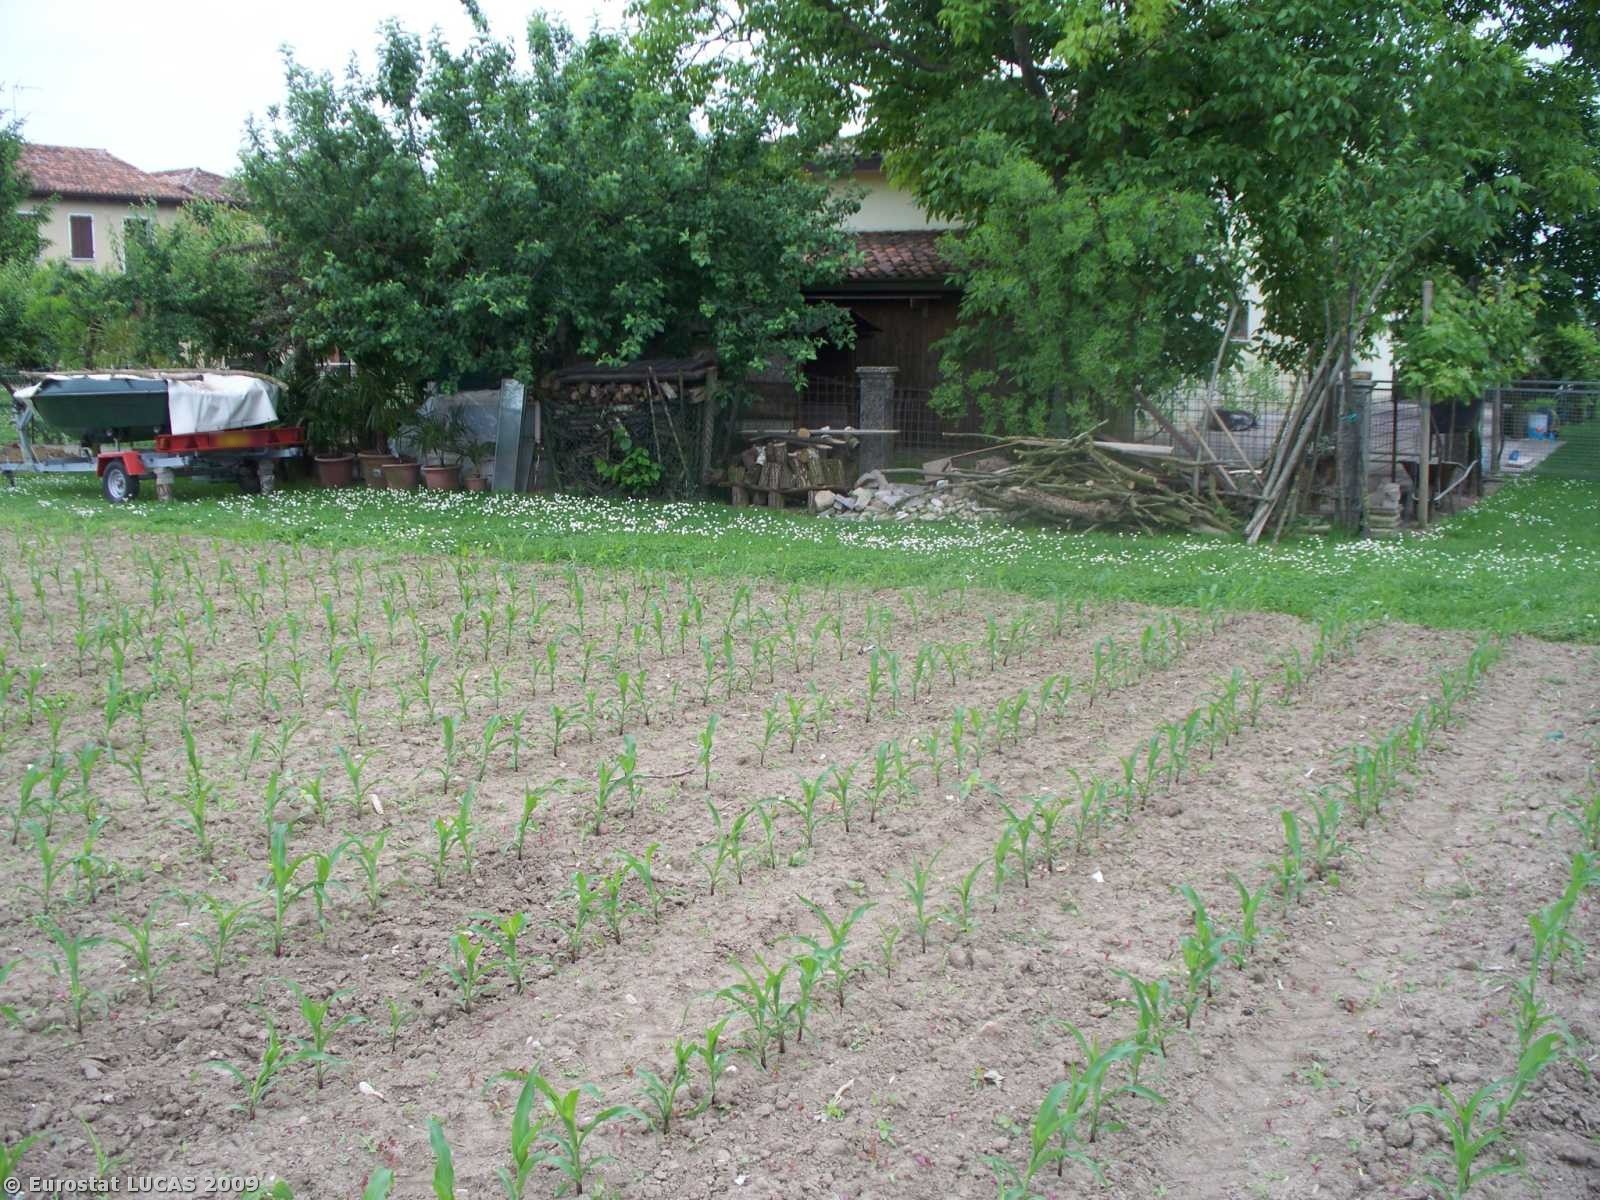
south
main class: Cropland
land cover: Maize
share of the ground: < 10 %
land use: Agriculture (excluding fallow land and kitchen gardens)
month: May
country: IT
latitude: 45.6881
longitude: 12.6286
